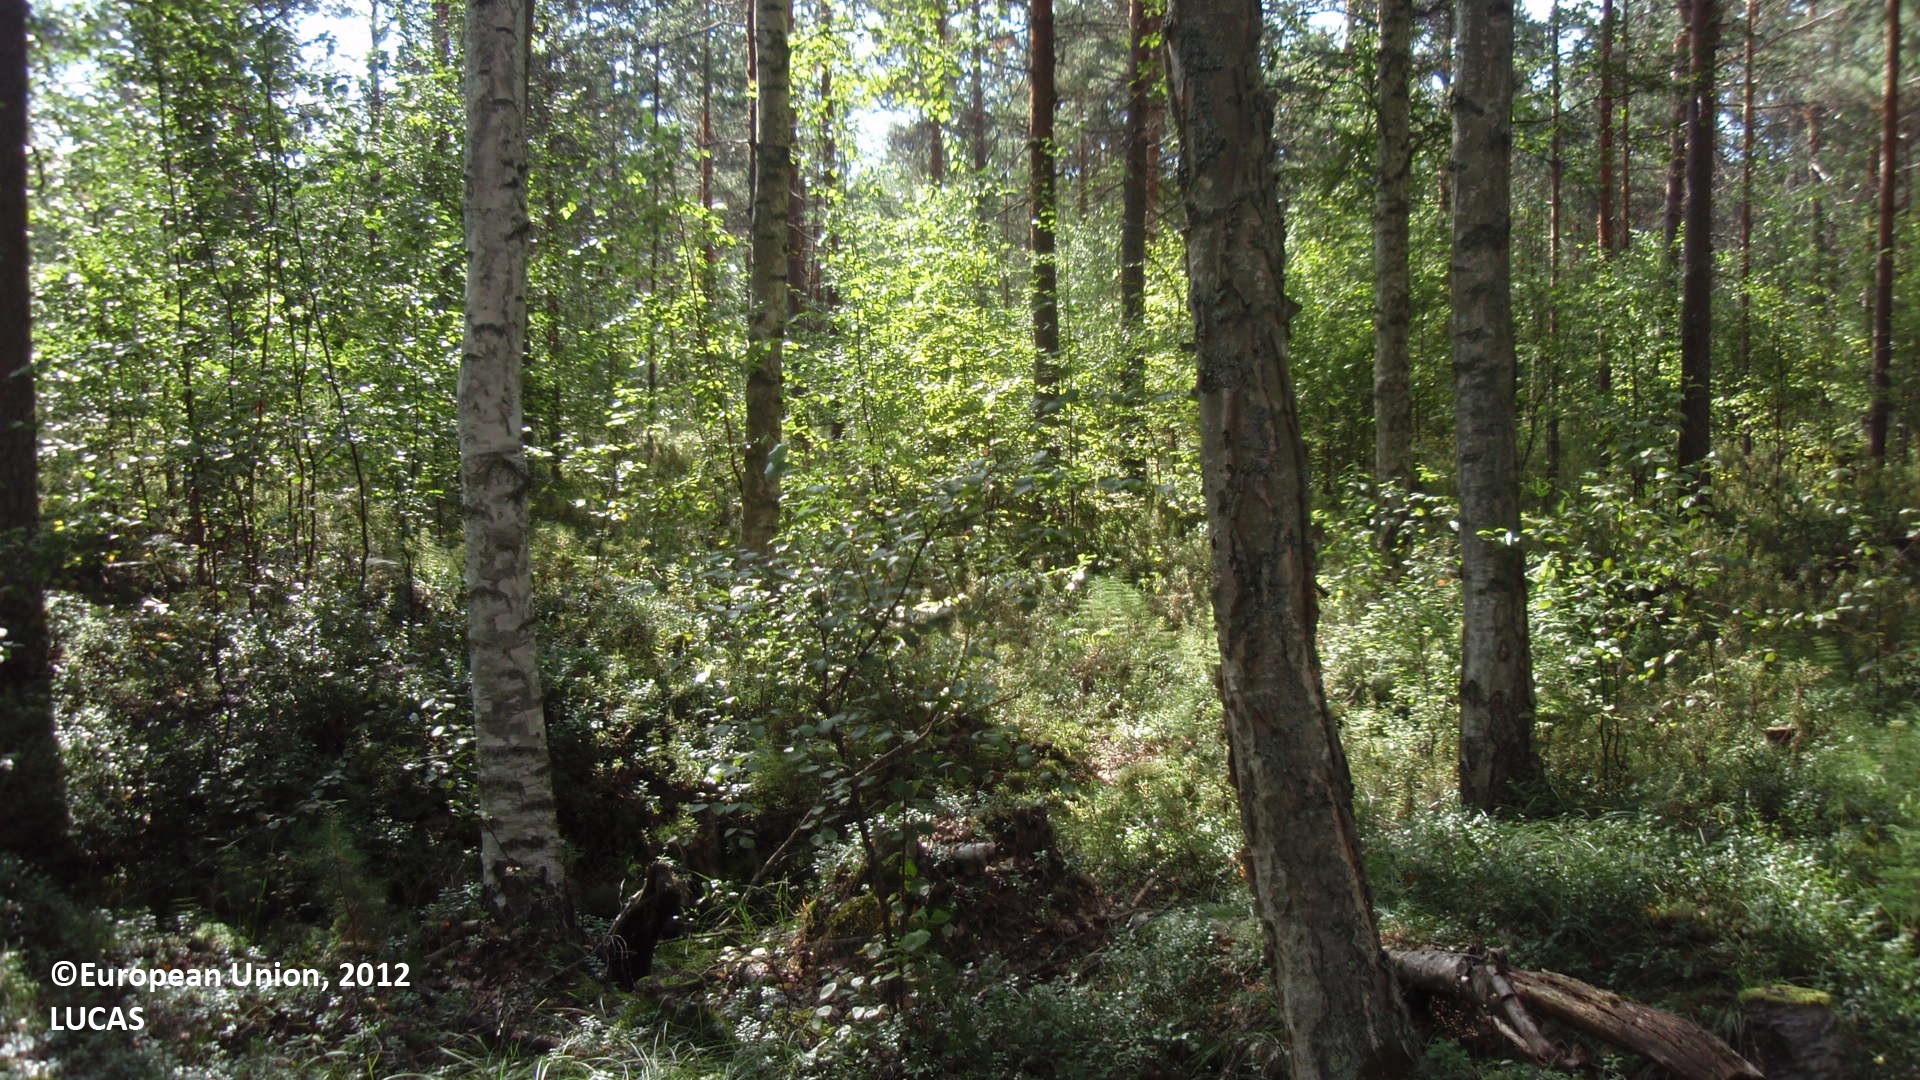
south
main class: Woodland
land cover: Pine dominated mixed woodland
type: boreal forest
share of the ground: 50 - 75 %
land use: Forestry
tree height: > 5 m
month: August
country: FI
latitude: 61.1951
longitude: 28.1565
